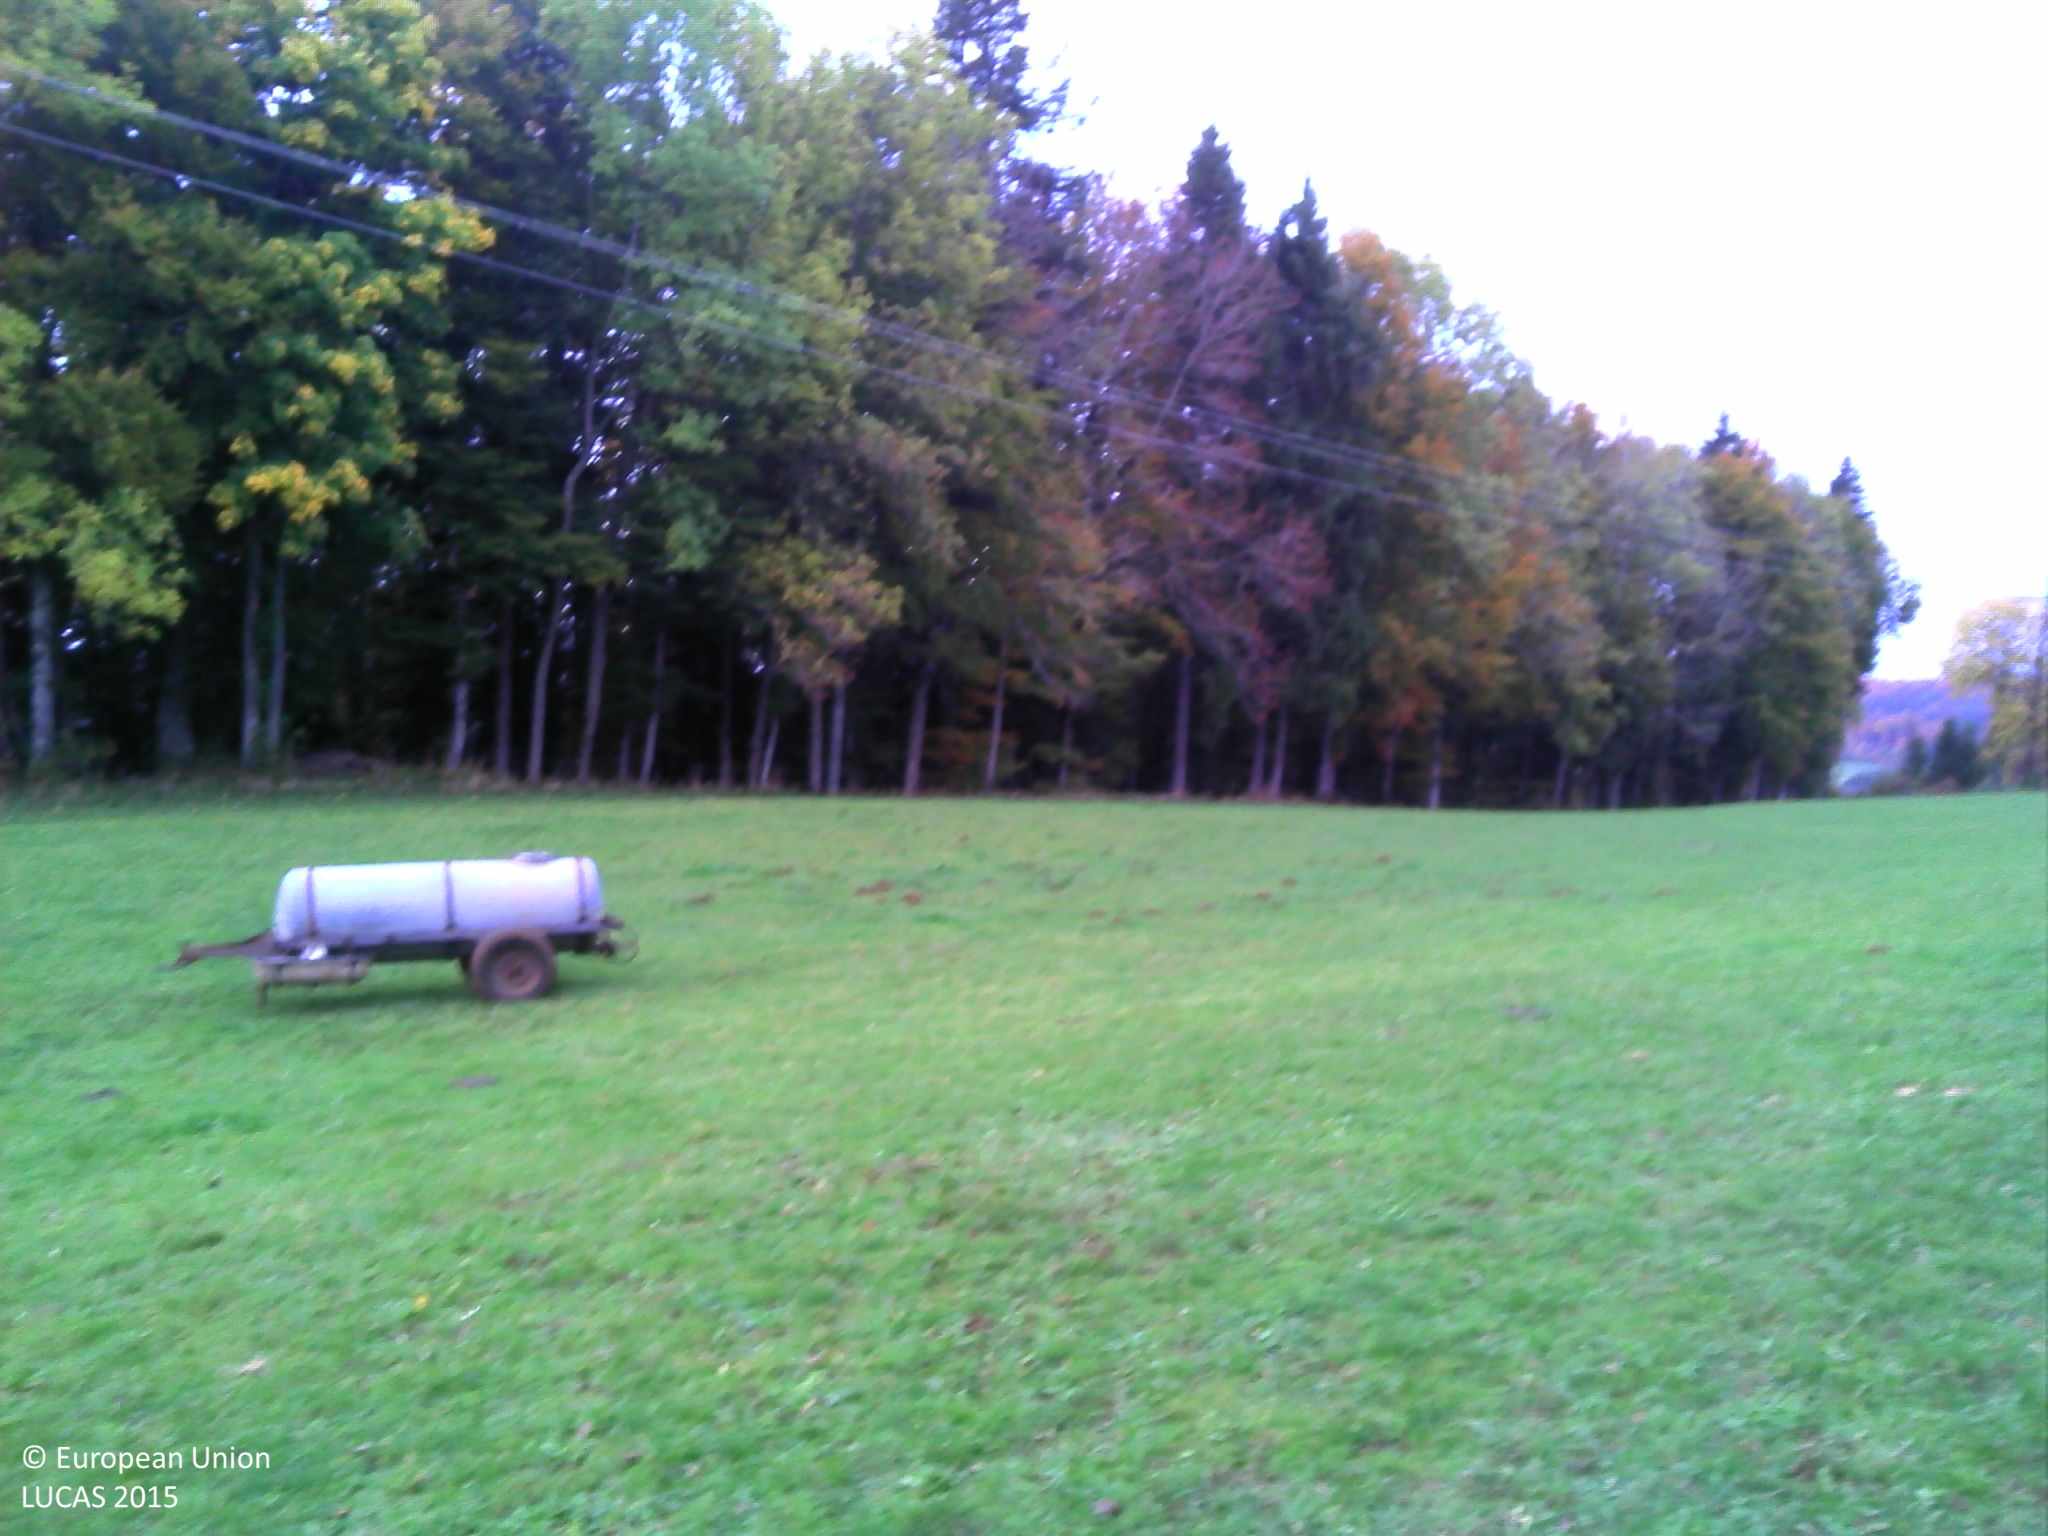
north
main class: Grassland
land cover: Grassland without tree/shrub cover
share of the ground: > 75 %
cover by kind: herbaceous plants 100 %
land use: Agriculture (excluding fallow land and kitchen gardens)
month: October
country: FR
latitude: 46.8296
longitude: 6.3449
